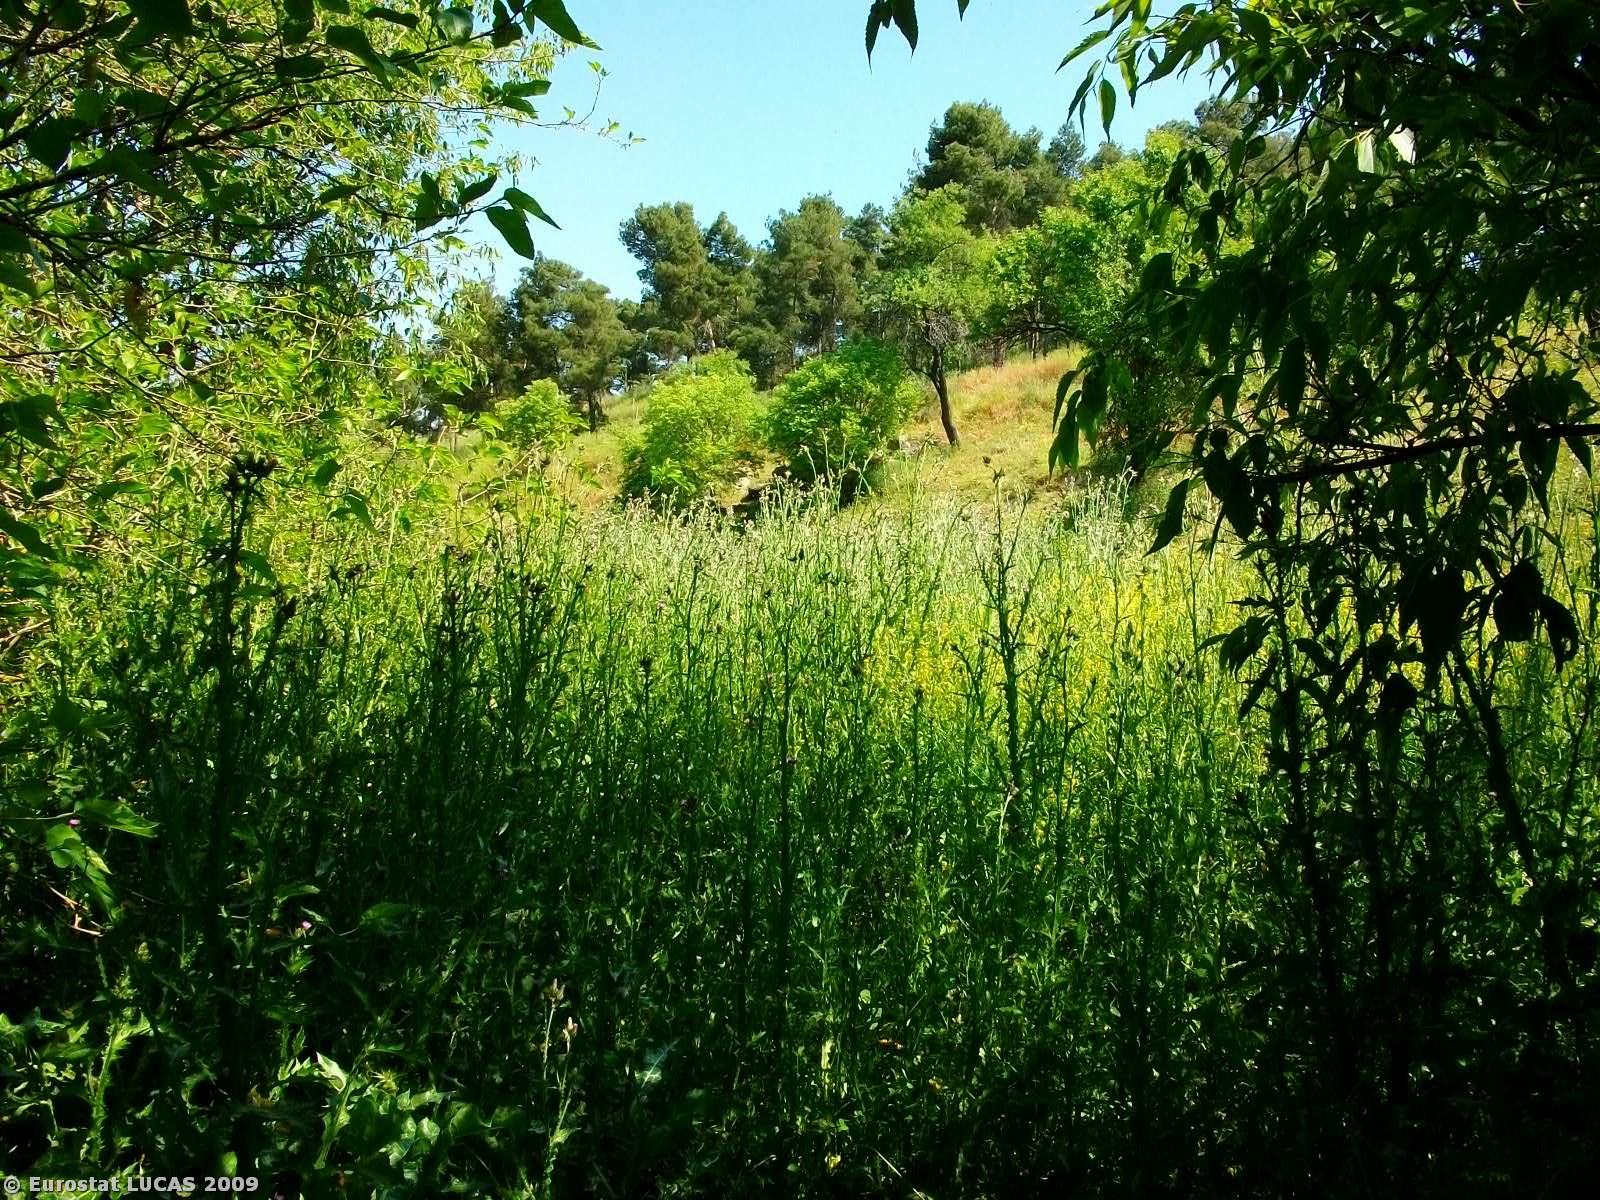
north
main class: Cropland
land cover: Nuts trees
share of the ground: 50 - 75 %
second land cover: Grassland with sparse tree/shrub cover
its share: > 75 %
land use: Agriculture (excluding fallow land and kitchen gardens)
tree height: > 5 m
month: May
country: GR
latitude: 39.3772
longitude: 22.7475
